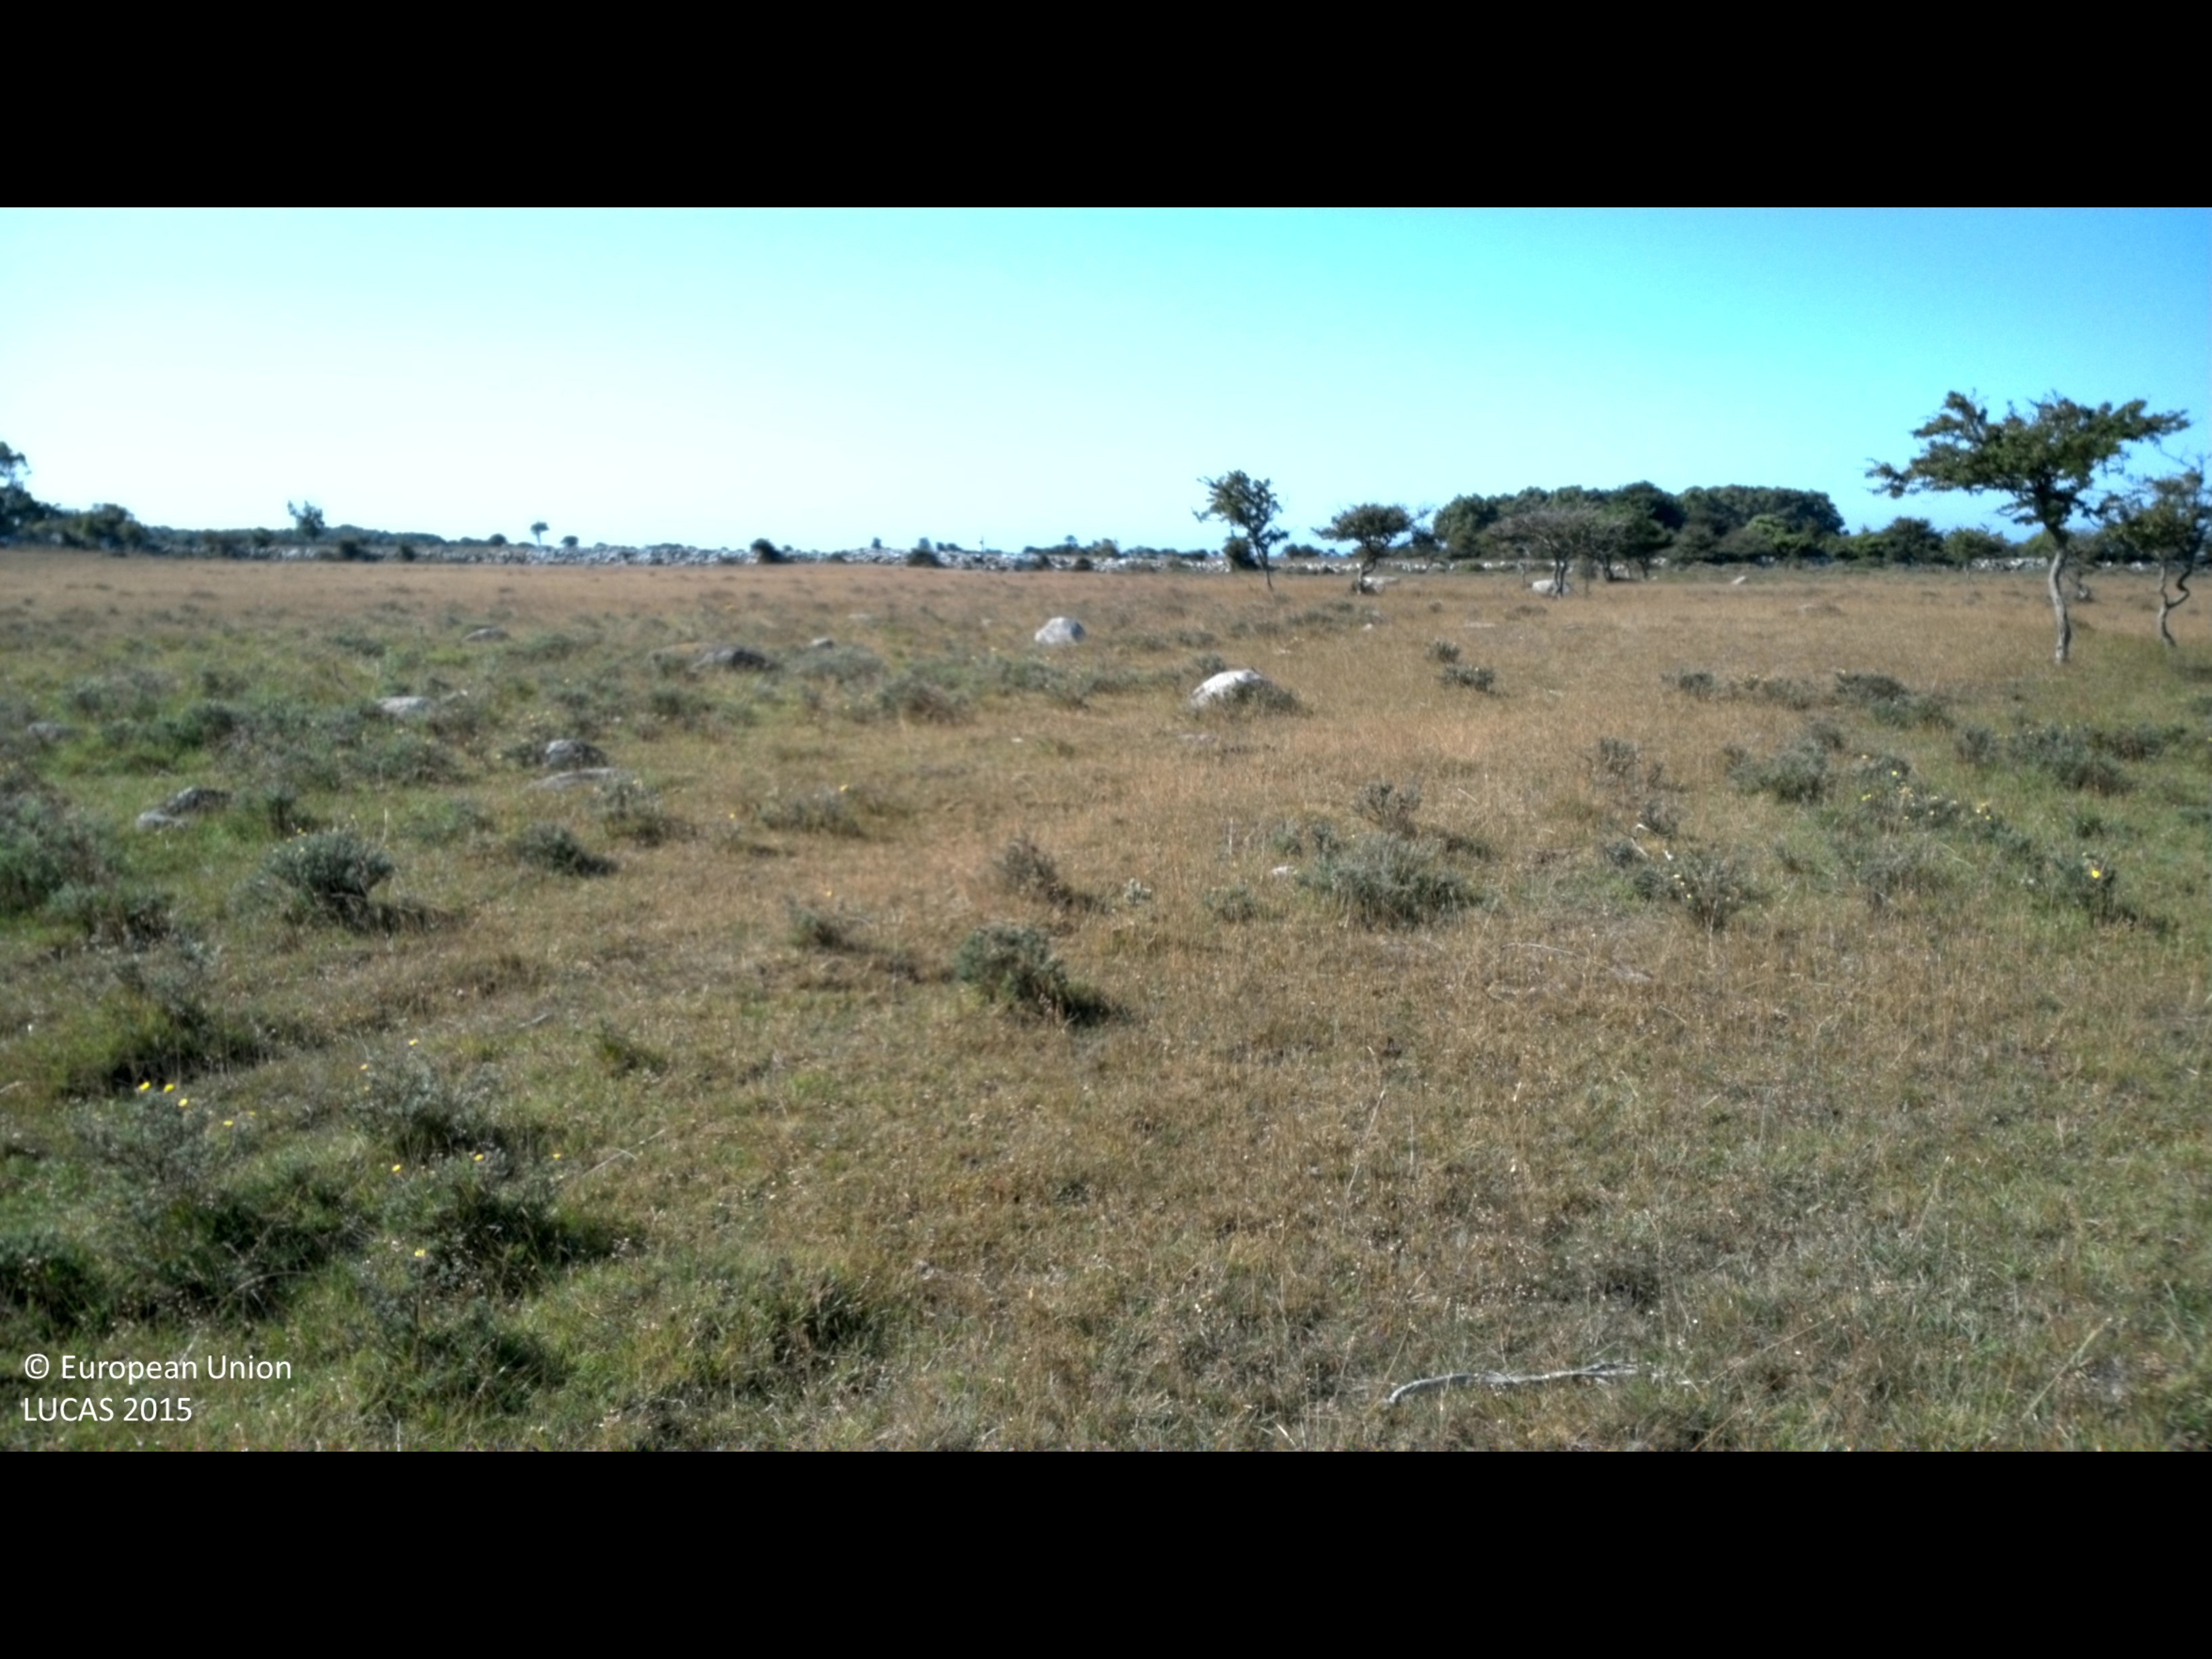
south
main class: Grassland
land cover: Grassland without tree/shrub cover
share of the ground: > 75 %
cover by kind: herbaceous plants 100 %
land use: Agriculture (excluding fallow land and kitchen gardens)
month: July
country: SE
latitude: 56.2263
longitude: 16.4054
